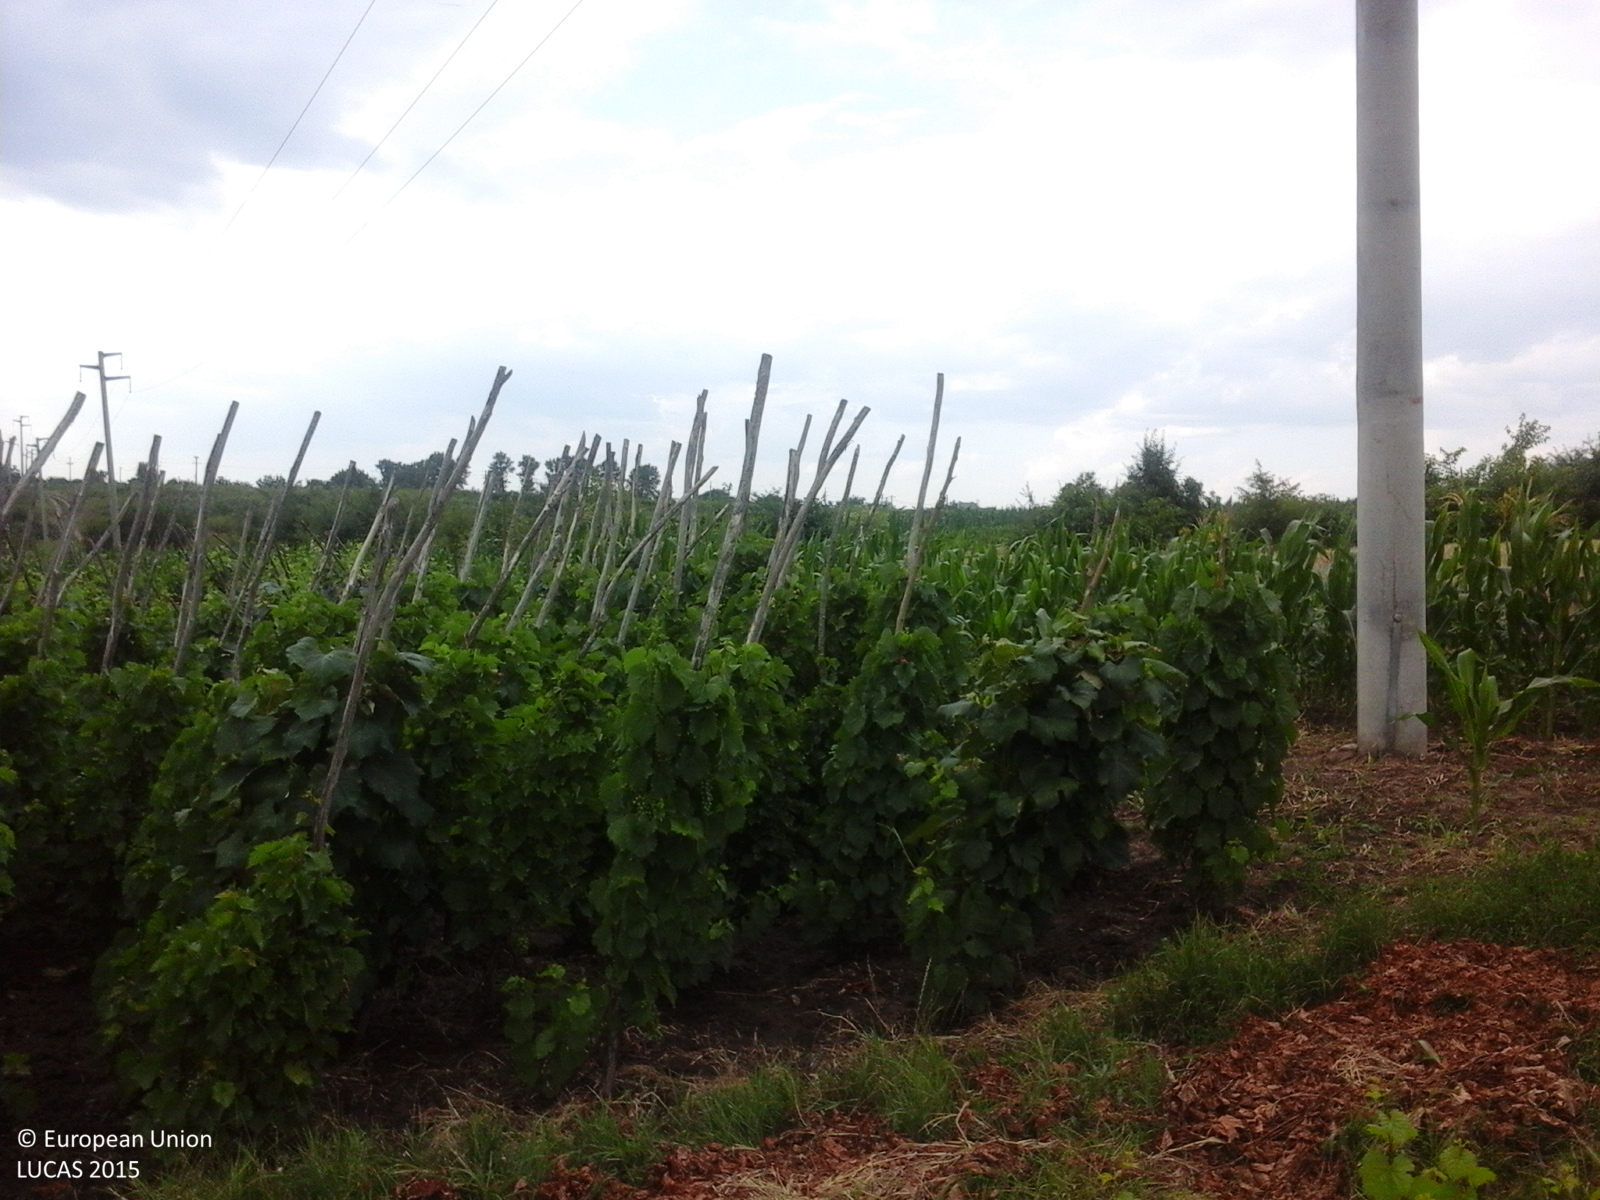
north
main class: Cropland
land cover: Vineyards
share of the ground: 10 - 25 %
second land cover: Maize
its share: 50 - 75 %
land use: Agriculture (excluding fallow land and kitchen gardens)
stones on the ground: < 10 %
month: June
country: RO
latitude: 44.1244
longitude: 26.1364
